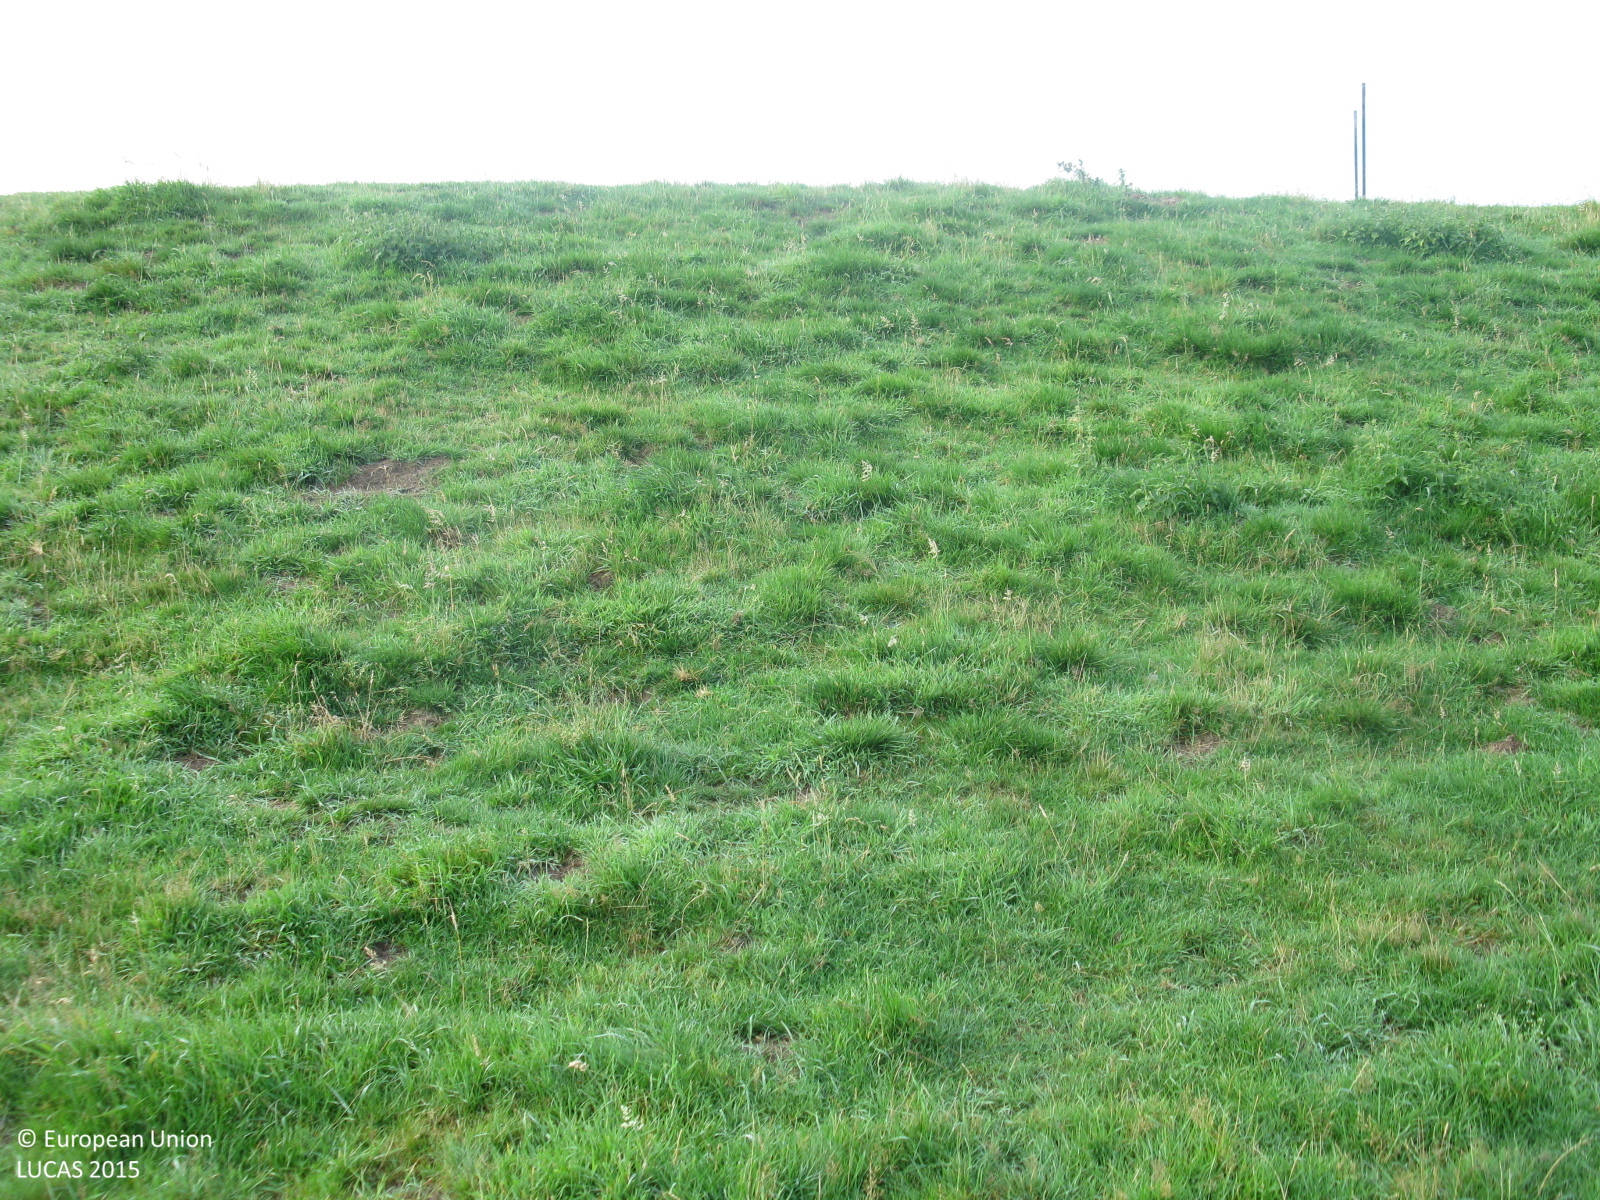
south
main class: Grassland
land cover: Grassland without tree/shrub cover
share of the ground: > 75 %
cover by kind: herbaceous plants 100 %
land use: Agriculture (excluding fallow land and kitchen gardens)
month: August
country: DE
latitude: 53.1748
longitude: 8.3399
